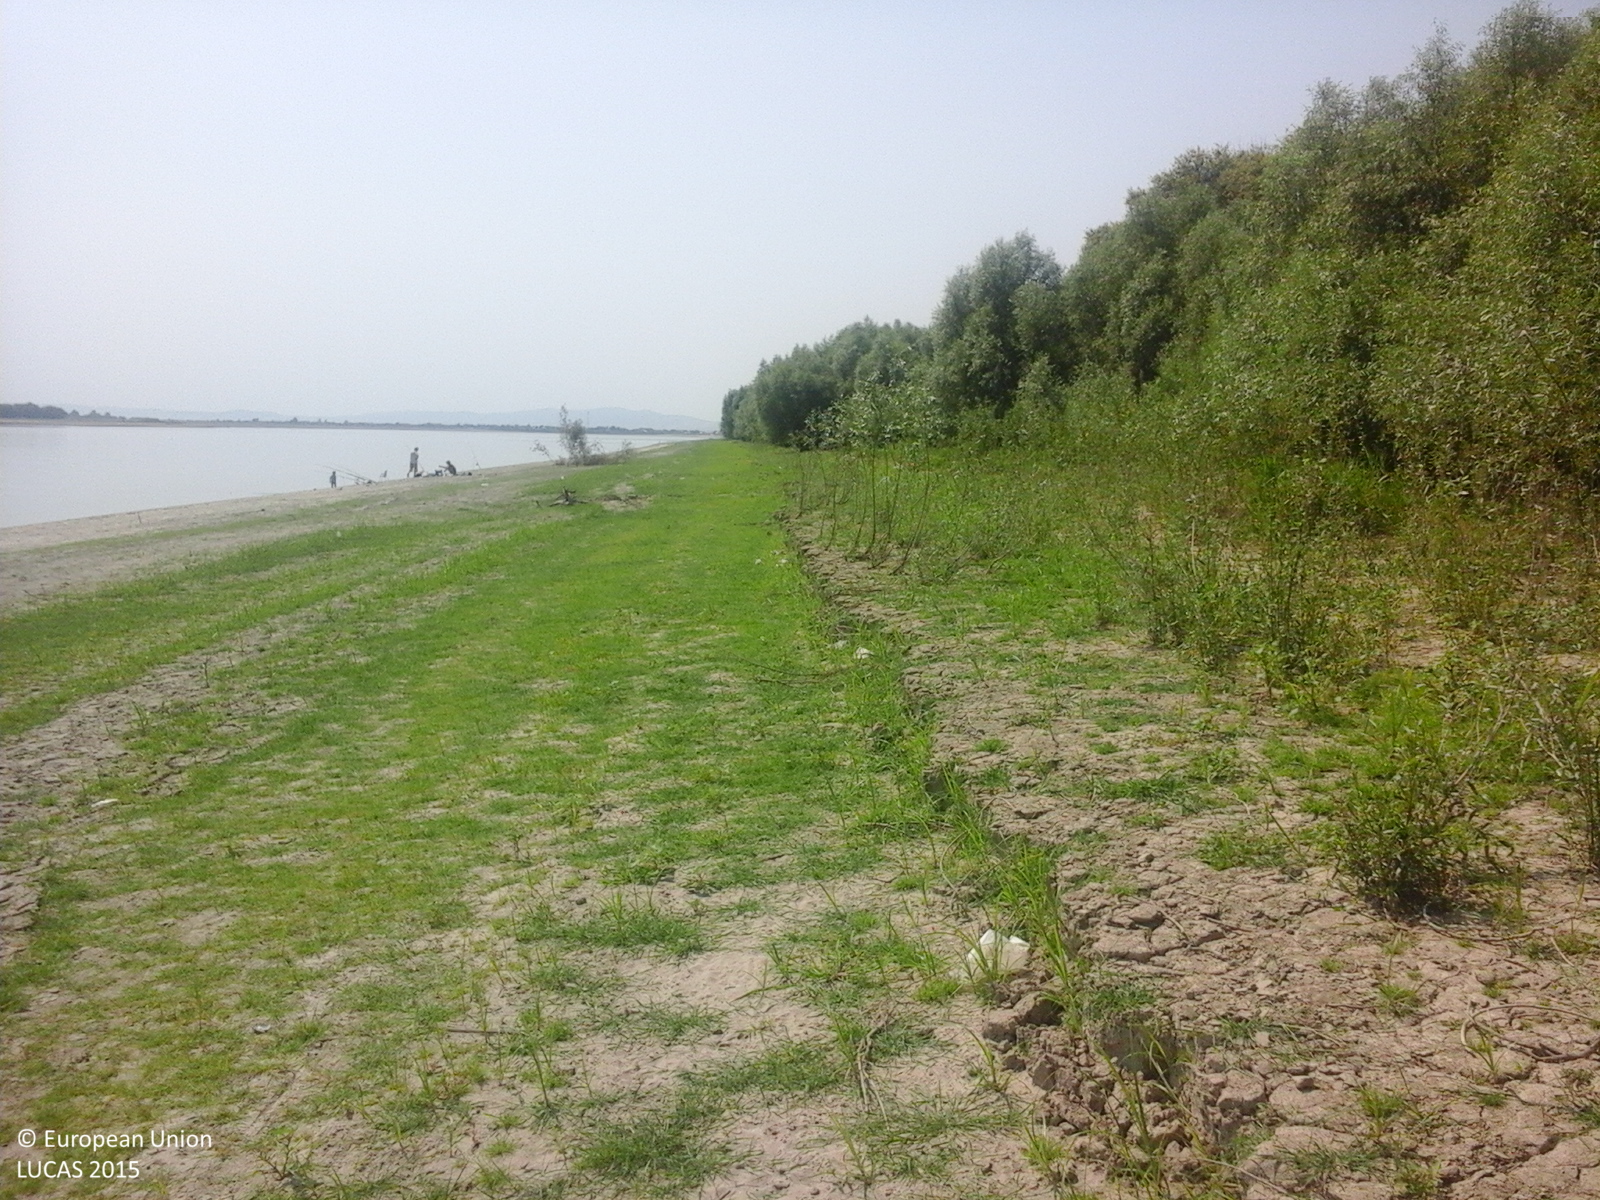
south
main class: Woodland
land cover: Broadleaved woodland
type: mire and swamp forests
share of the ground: > 75 %
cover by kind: broadleaved forest trees 100 %
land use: Semi-natural and natural areas not in use
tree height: > 5 m
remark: Temporary dry
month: July
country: RO
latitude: 45.4390
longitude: 28.1867
